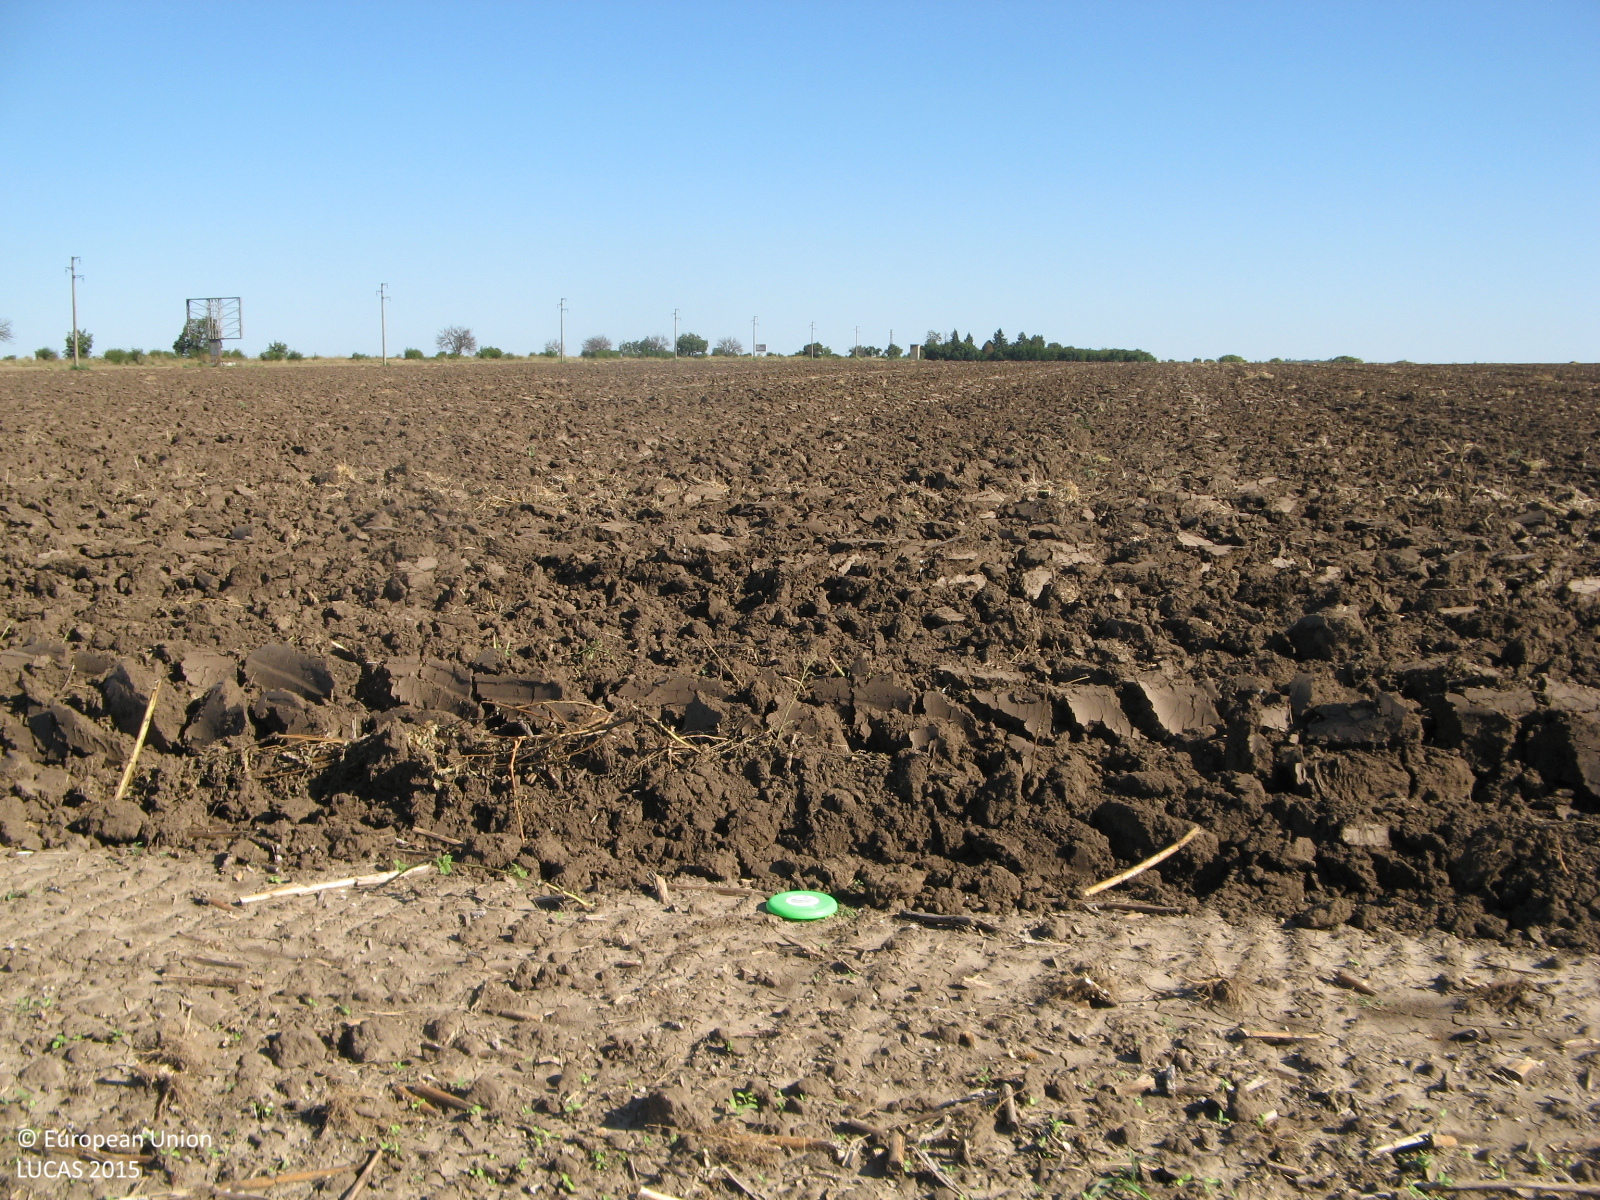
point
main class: Cropland
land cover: Sunflower
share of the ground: < 10 %
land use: Agriculture (excluding fallow land and kitchen gardens)
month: September
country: BG
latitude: 43.7263
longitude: 26.0991
